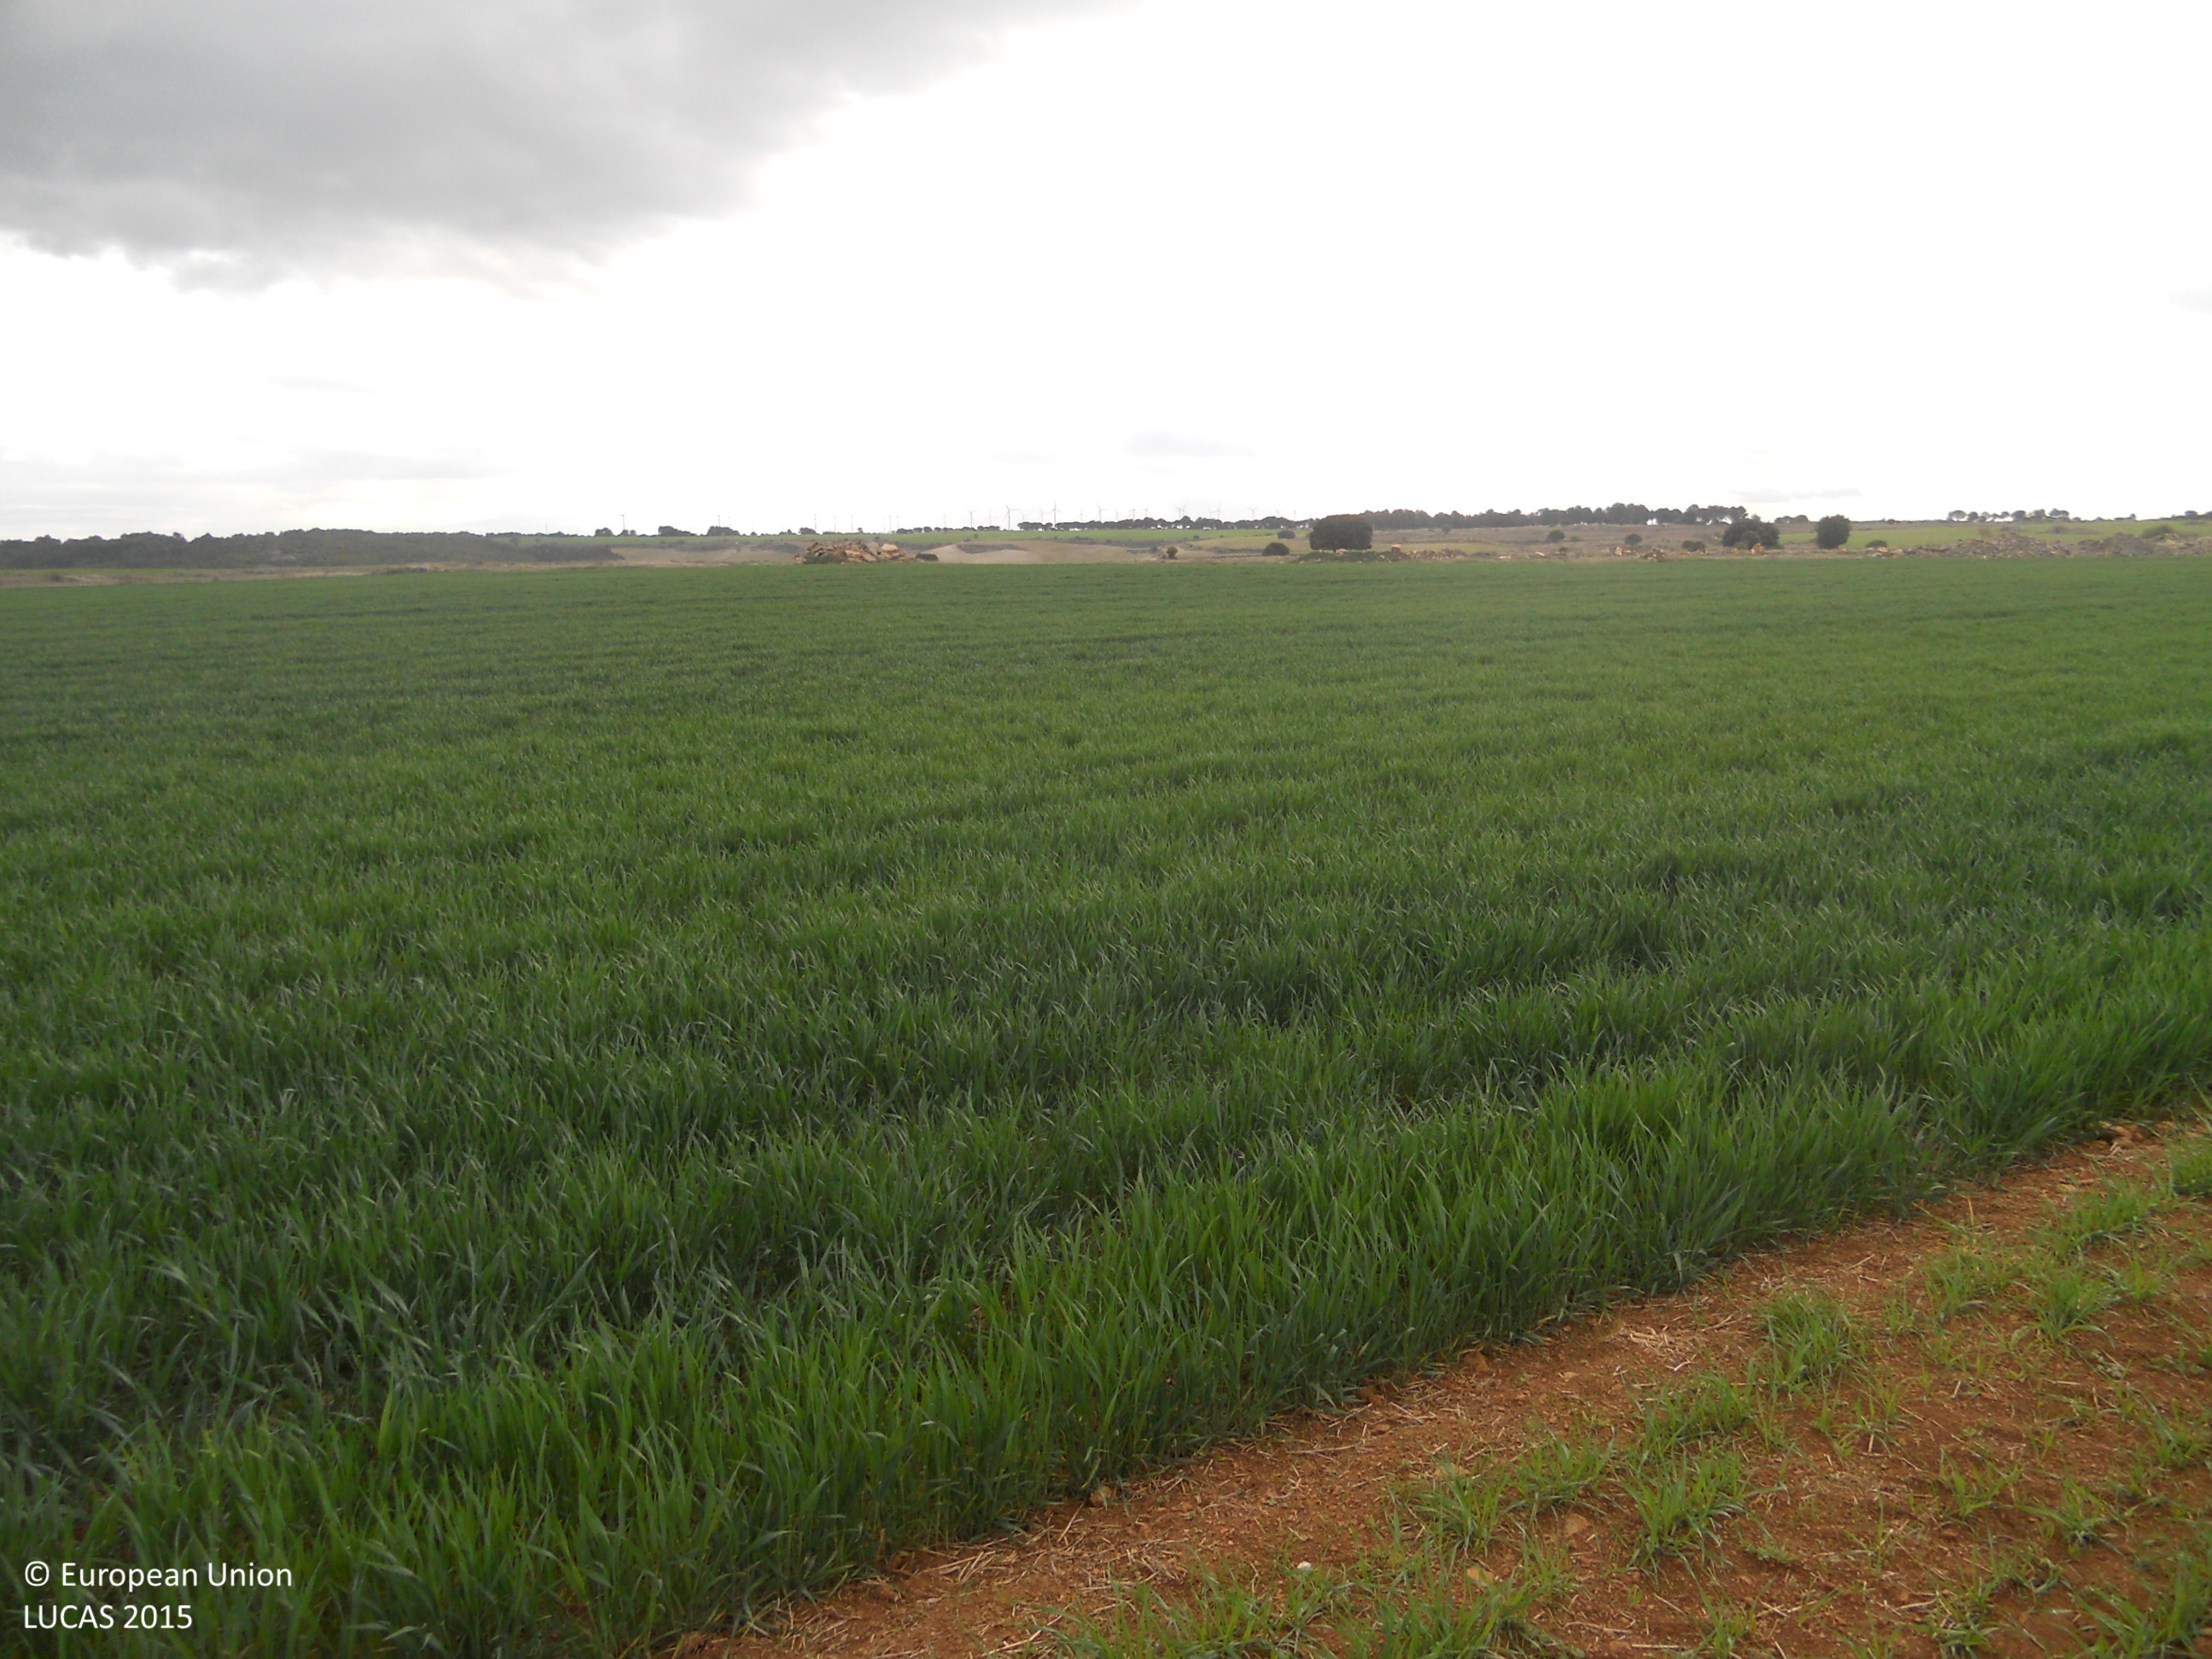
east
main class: Cropland
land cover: Barley
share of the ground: > 75 %
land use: Agriculture (excluding fallow land and kitchen gardens)
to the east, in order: Barley; Grassland without tree/shrub cover; Grassland with sparse tree/shrub cover
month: April
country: ES
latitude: 42.1767
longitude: -4.3423
